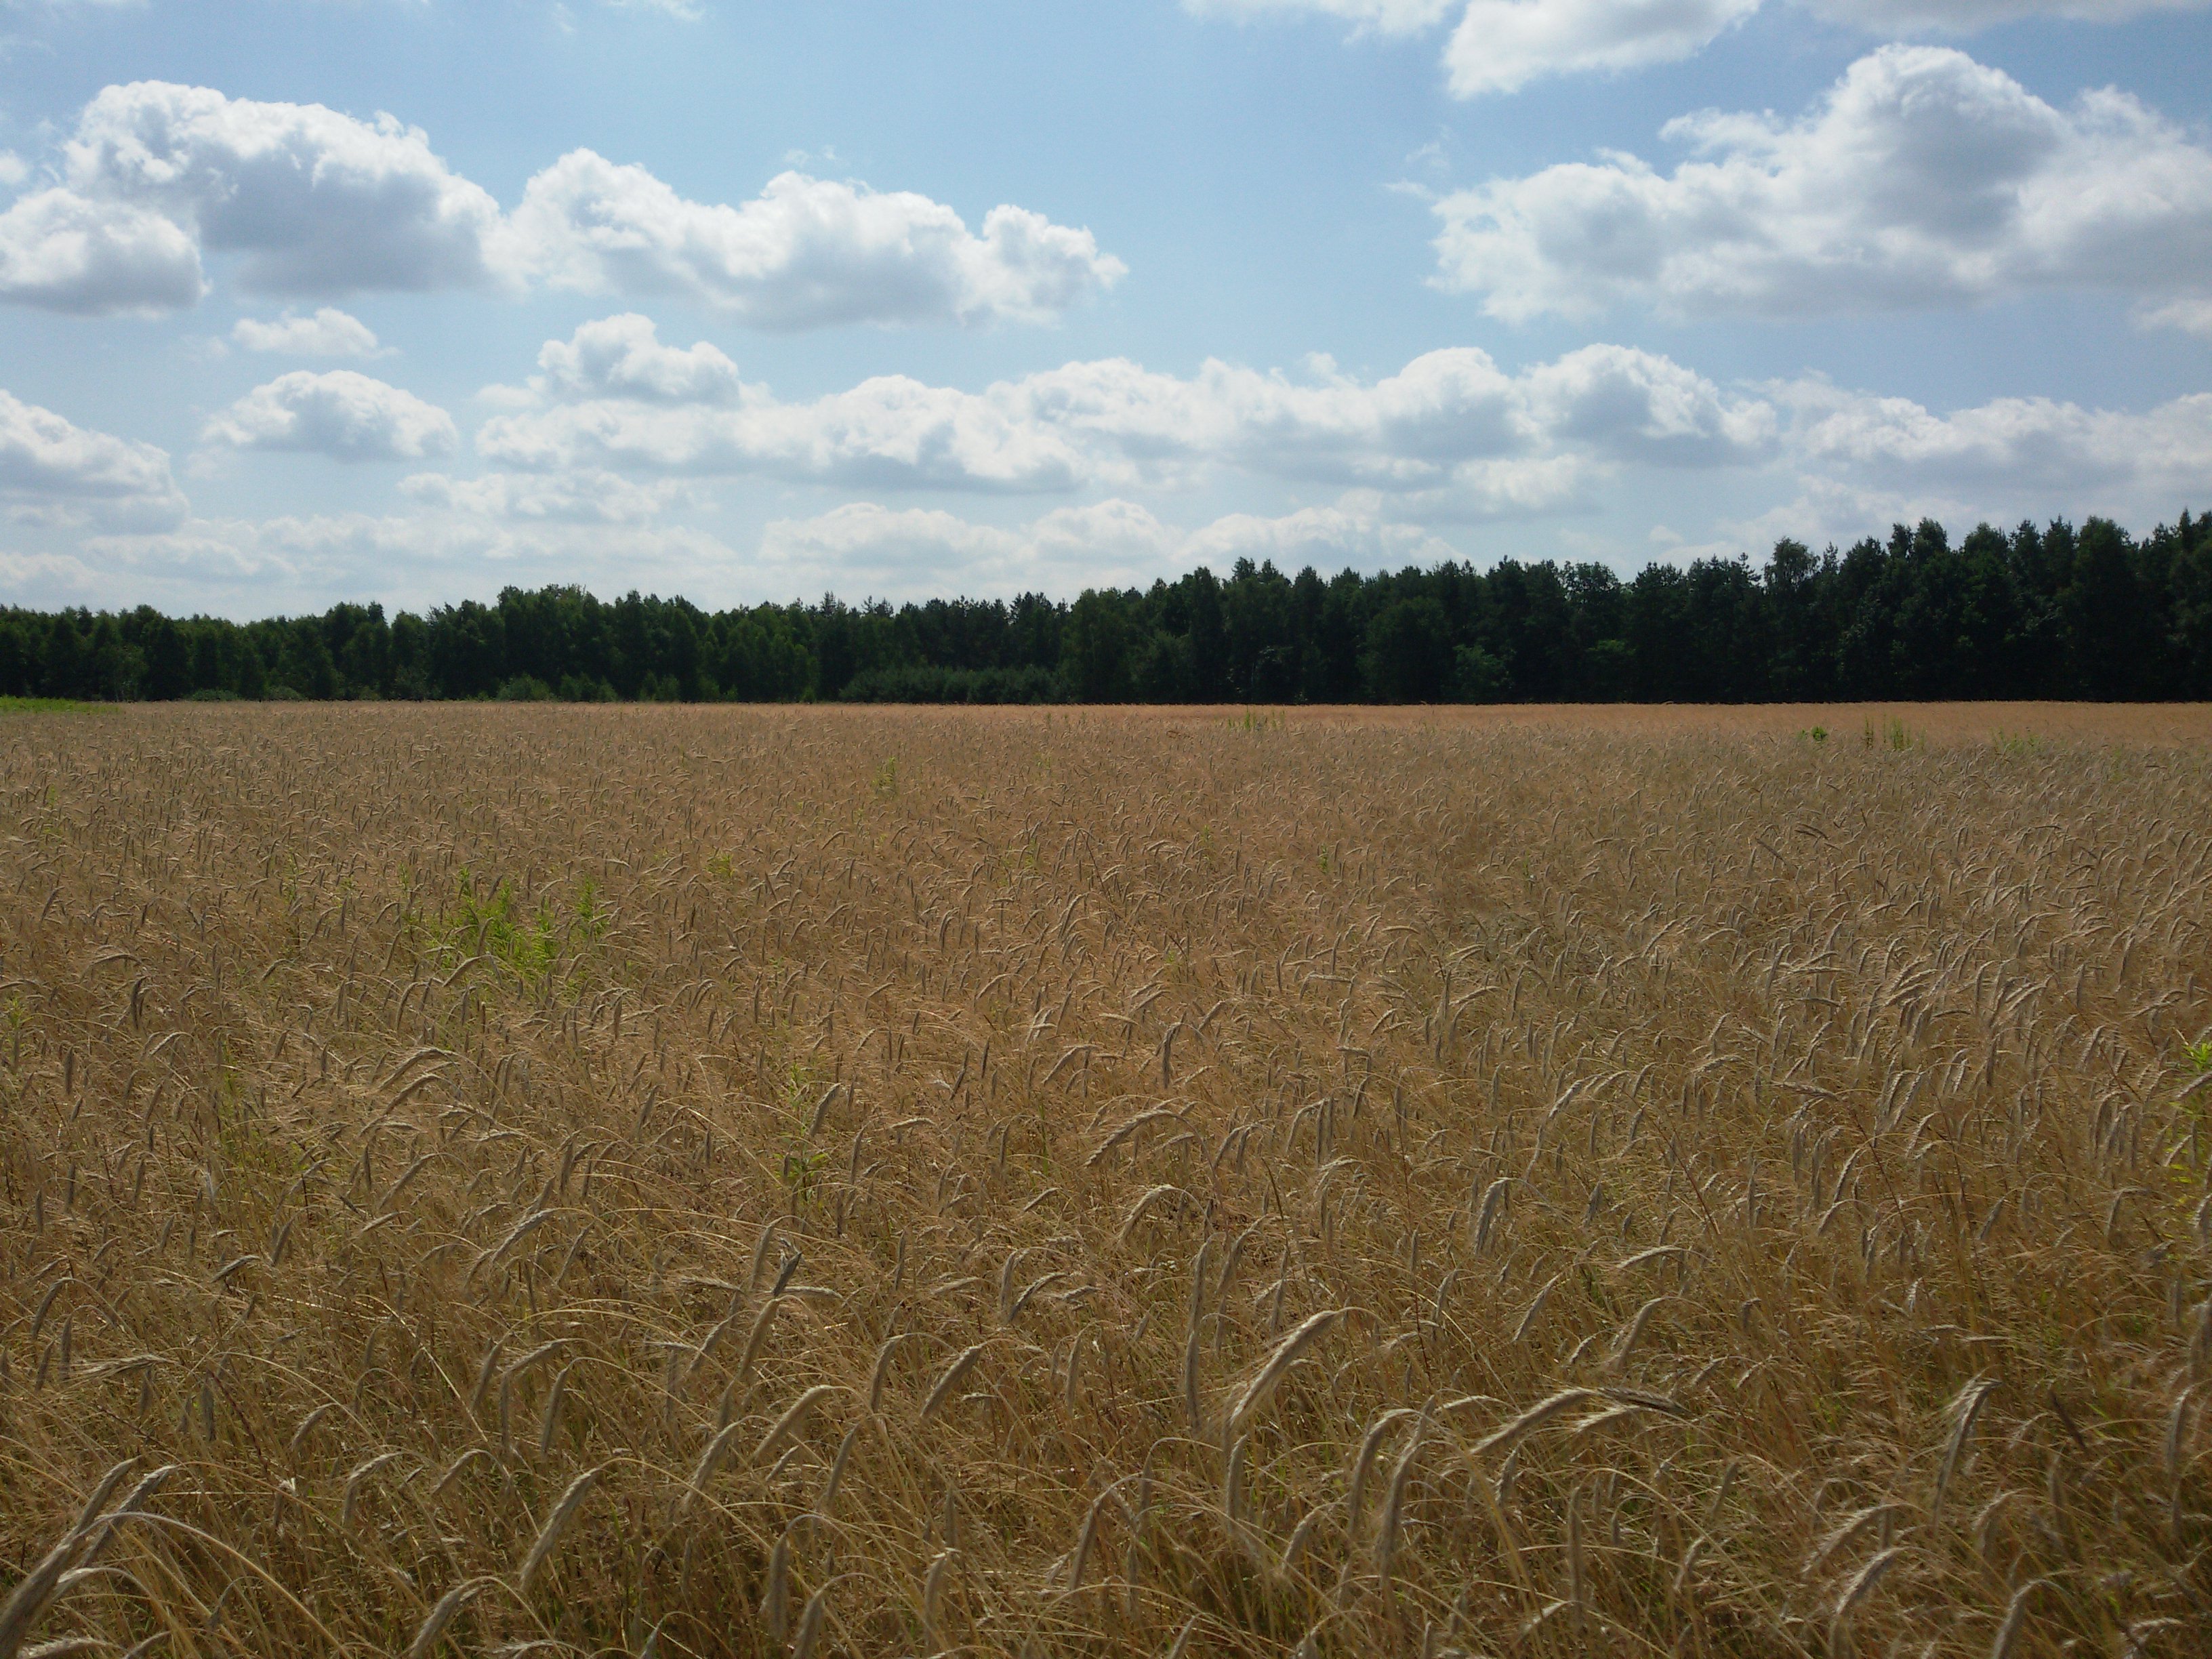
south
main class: Cropland
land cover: Rye
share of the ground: > 75 %
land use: Agriculture (excluding fallow land and kitchen gardens)
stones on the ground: < 10 %
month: July
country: PL
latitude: 50.2512
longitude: 22.3914
